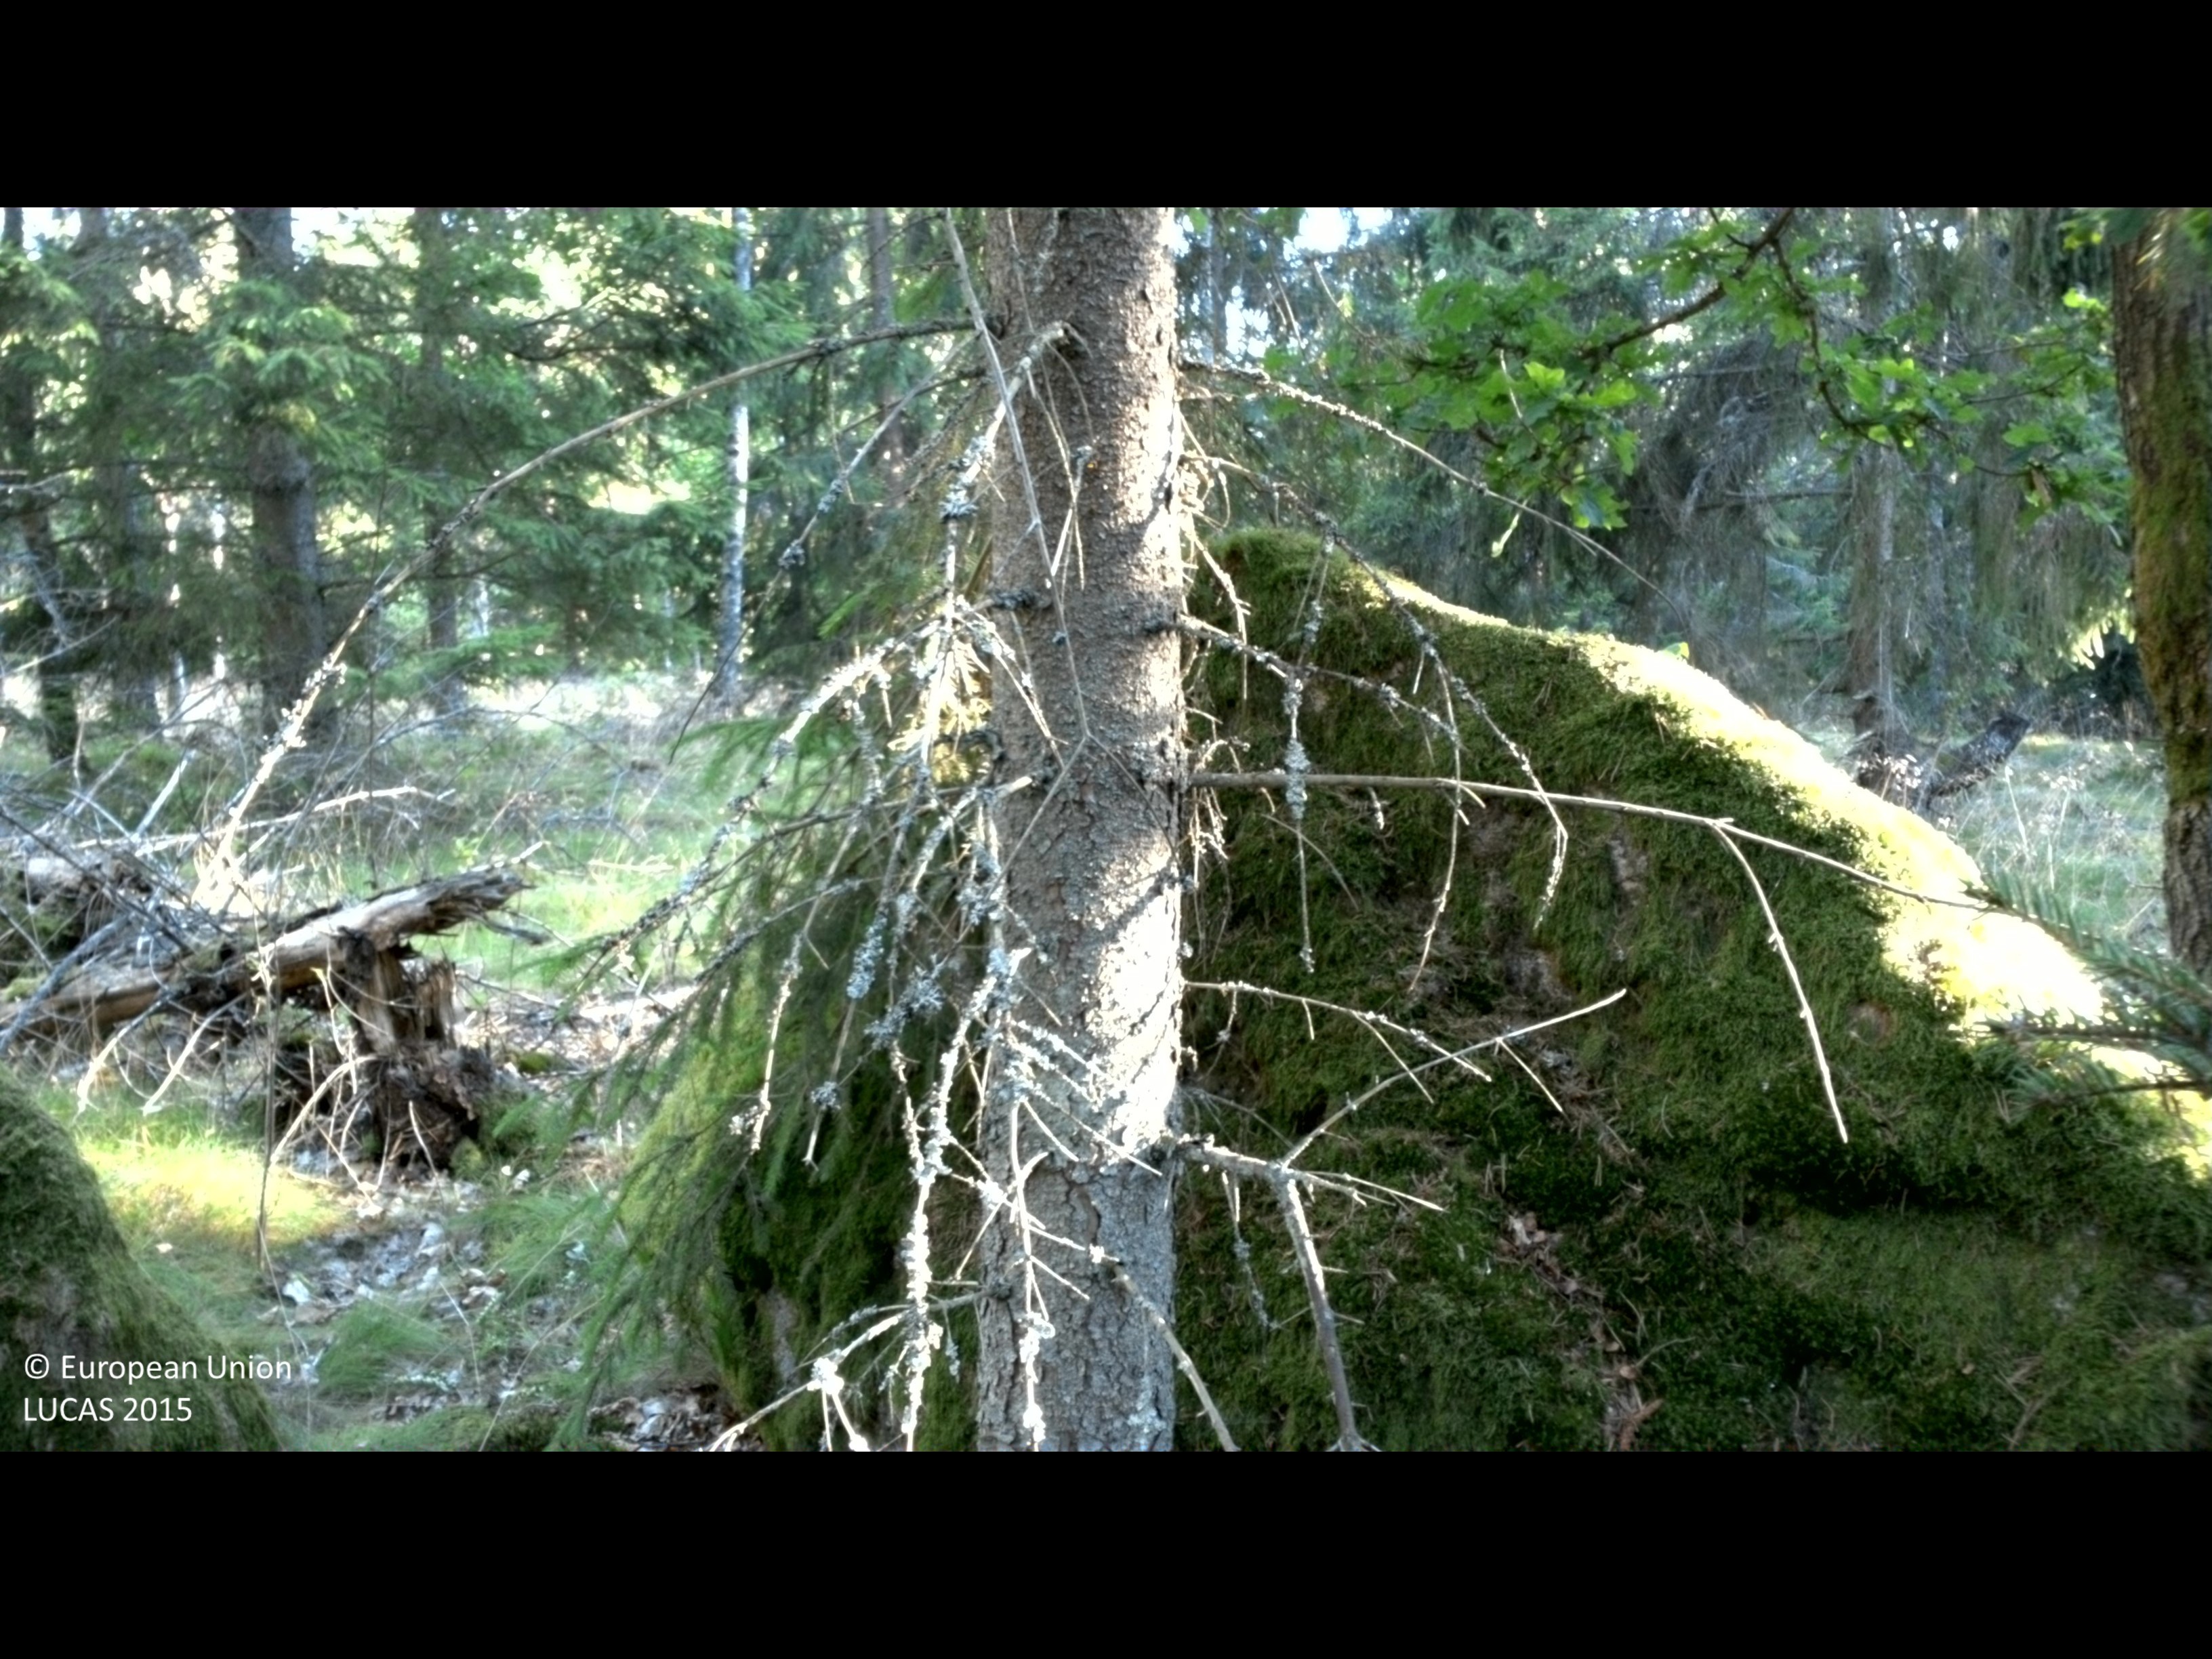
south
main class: Woodland
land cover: Spruce dominated coniferous woodland
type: boreal forest
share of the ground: 50 - 75 %
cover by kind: coniferous forest trees 55 %, herbaceous plants 20 %, lichens and mosses 20 %, broadleaved forest trees 5 %
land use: Forestry
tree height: > 5 m
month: August
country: SE
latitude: 56.2442
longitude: 15.2111
